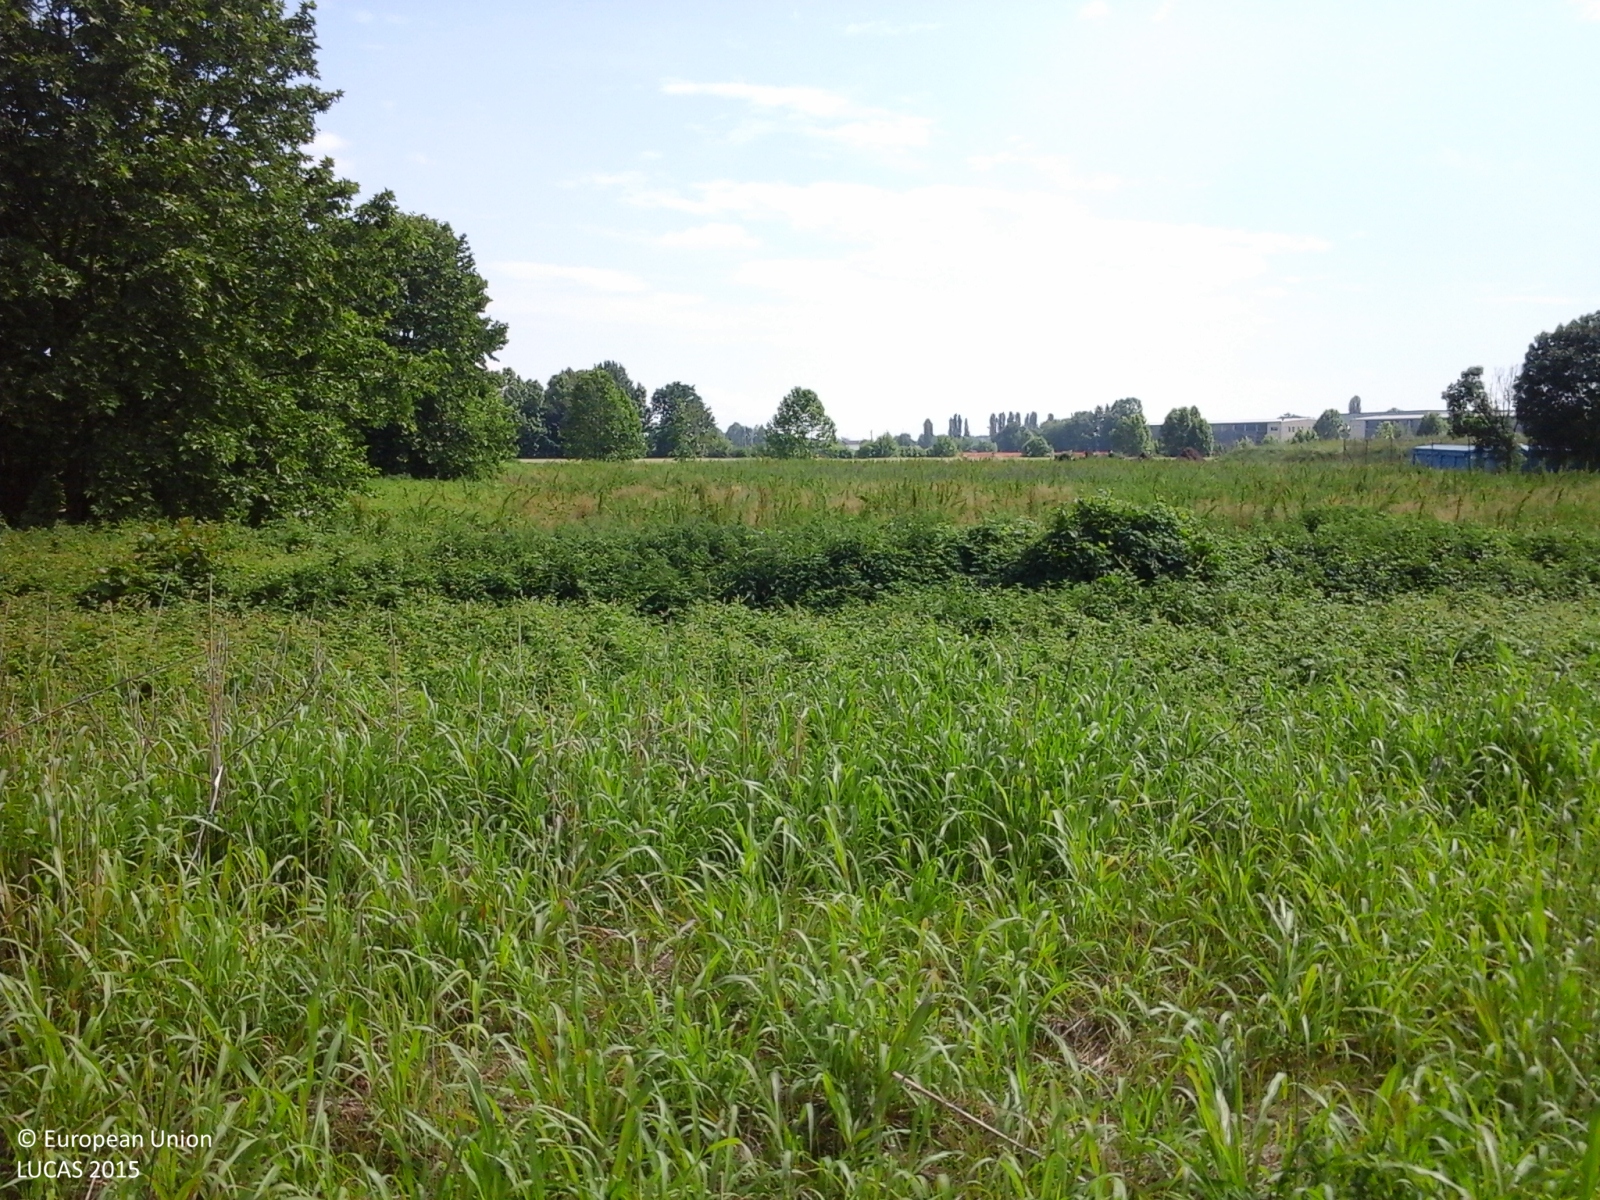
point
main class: Grassland
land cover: Spontaneously vegetated surfaces
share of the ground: > 75 %
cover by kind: herbaceous plants 100 %
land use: Fallow land
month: May
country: IT
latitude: 45.4858
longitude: 9.6551
